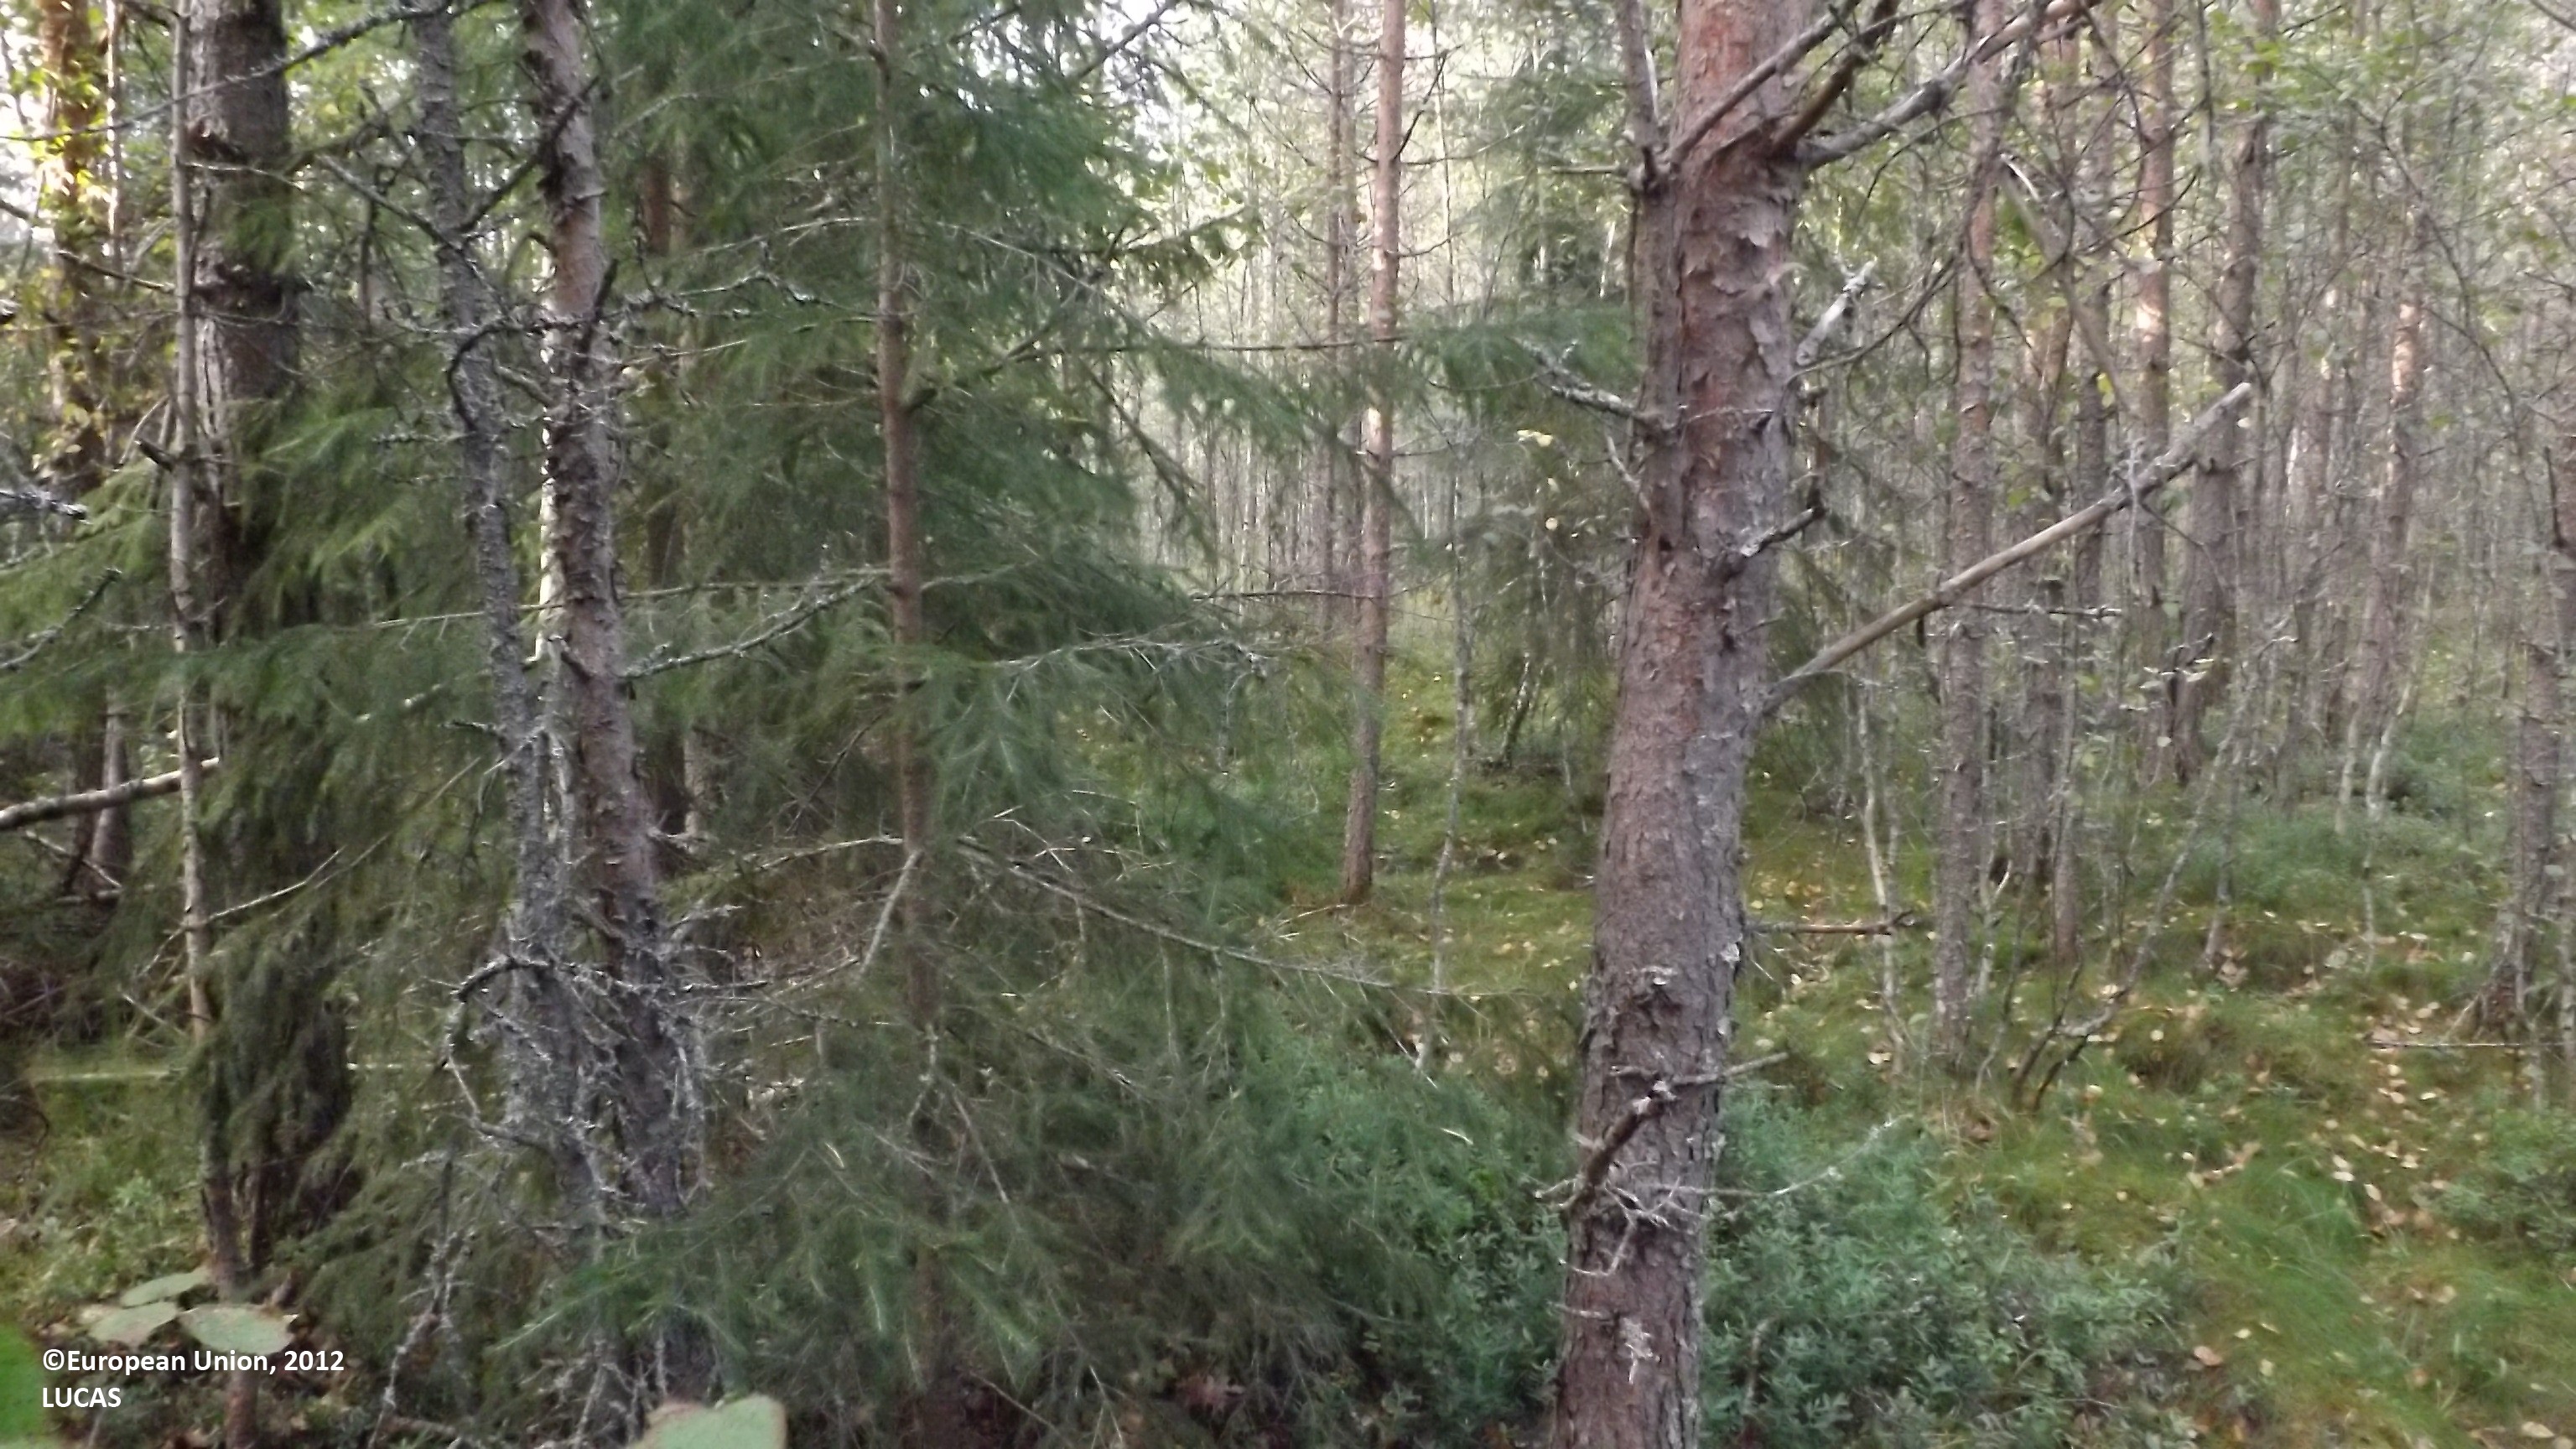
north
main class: Woodland
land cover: Other mixed woodland
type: boreal forest
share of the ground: > 75 %
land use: Forestry
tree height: > 5 m
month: August
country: FI
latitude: 63.7382
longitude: 23.9841
